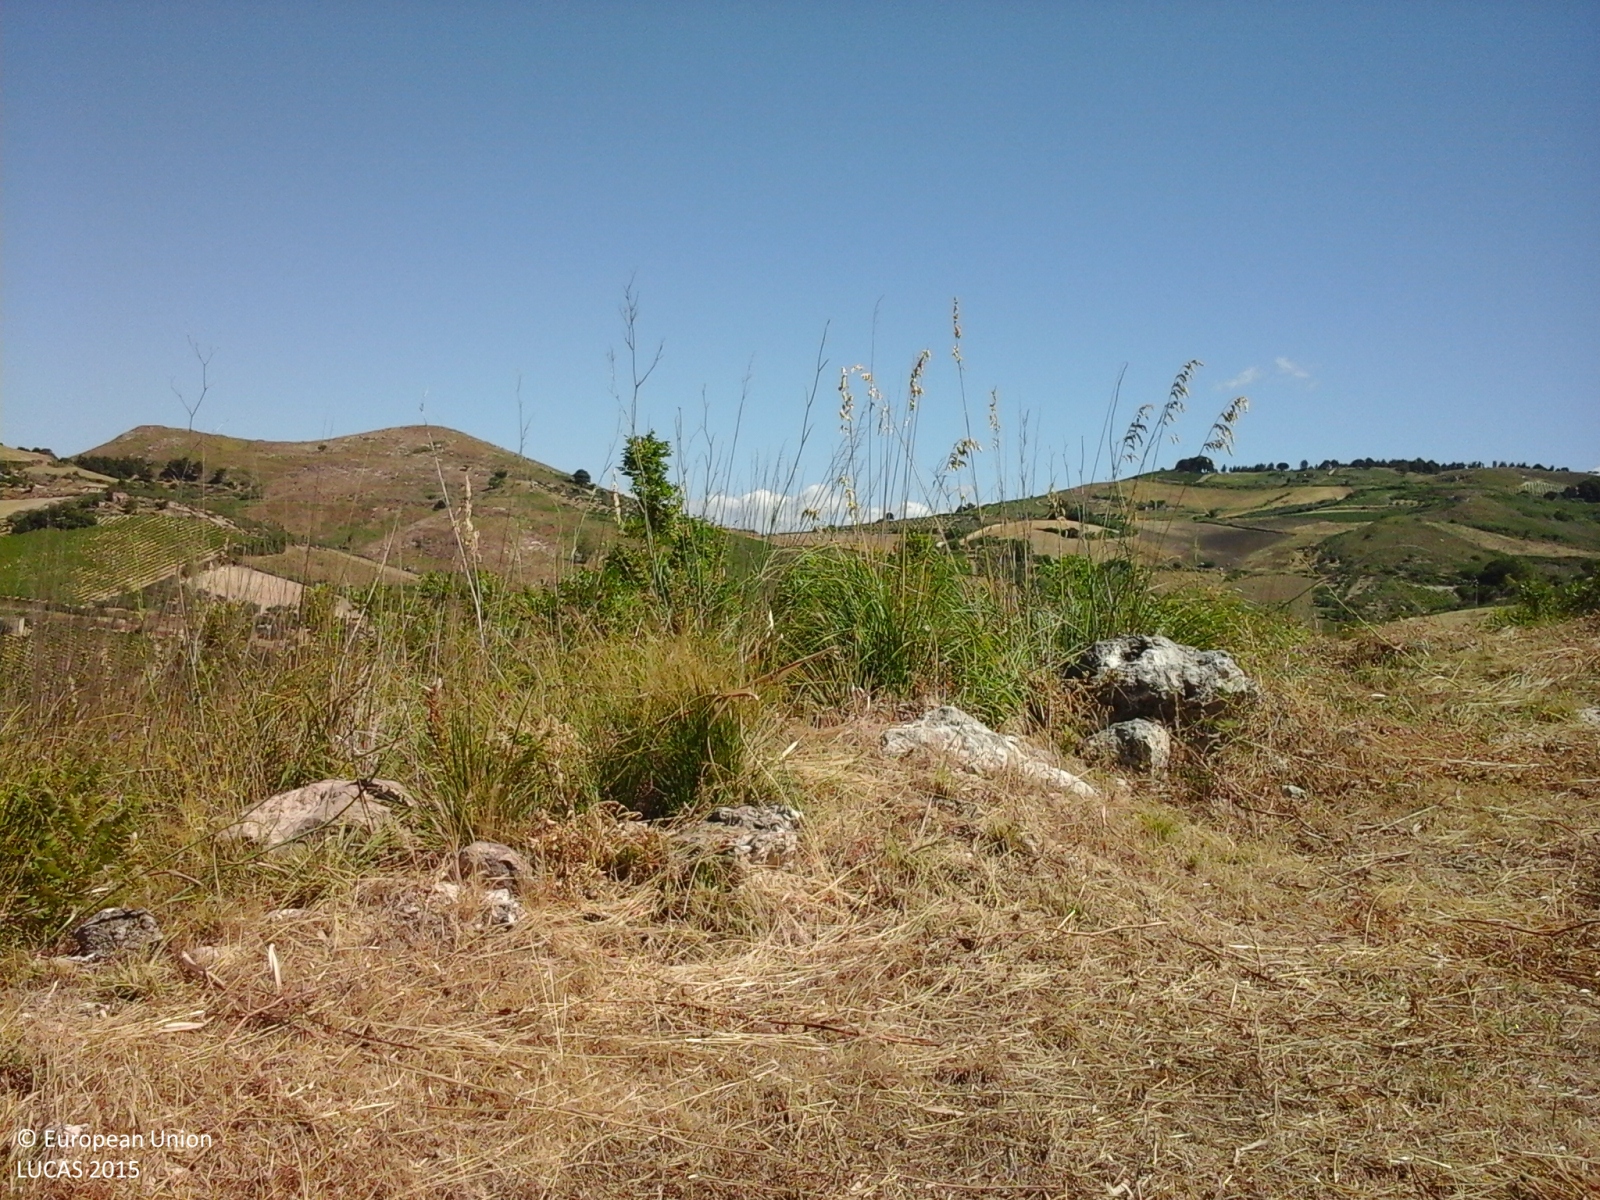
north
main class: Grassland
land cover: Grassland without tree/shrub cover
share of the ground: > 75 %
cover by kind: herbaceous plants 90 %, unconsolidated bare surface 10 %
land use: Agriculture (excluding fallow land and kitchen gardens)
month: June
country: IT
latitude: 37.7915
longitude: 12.9872
